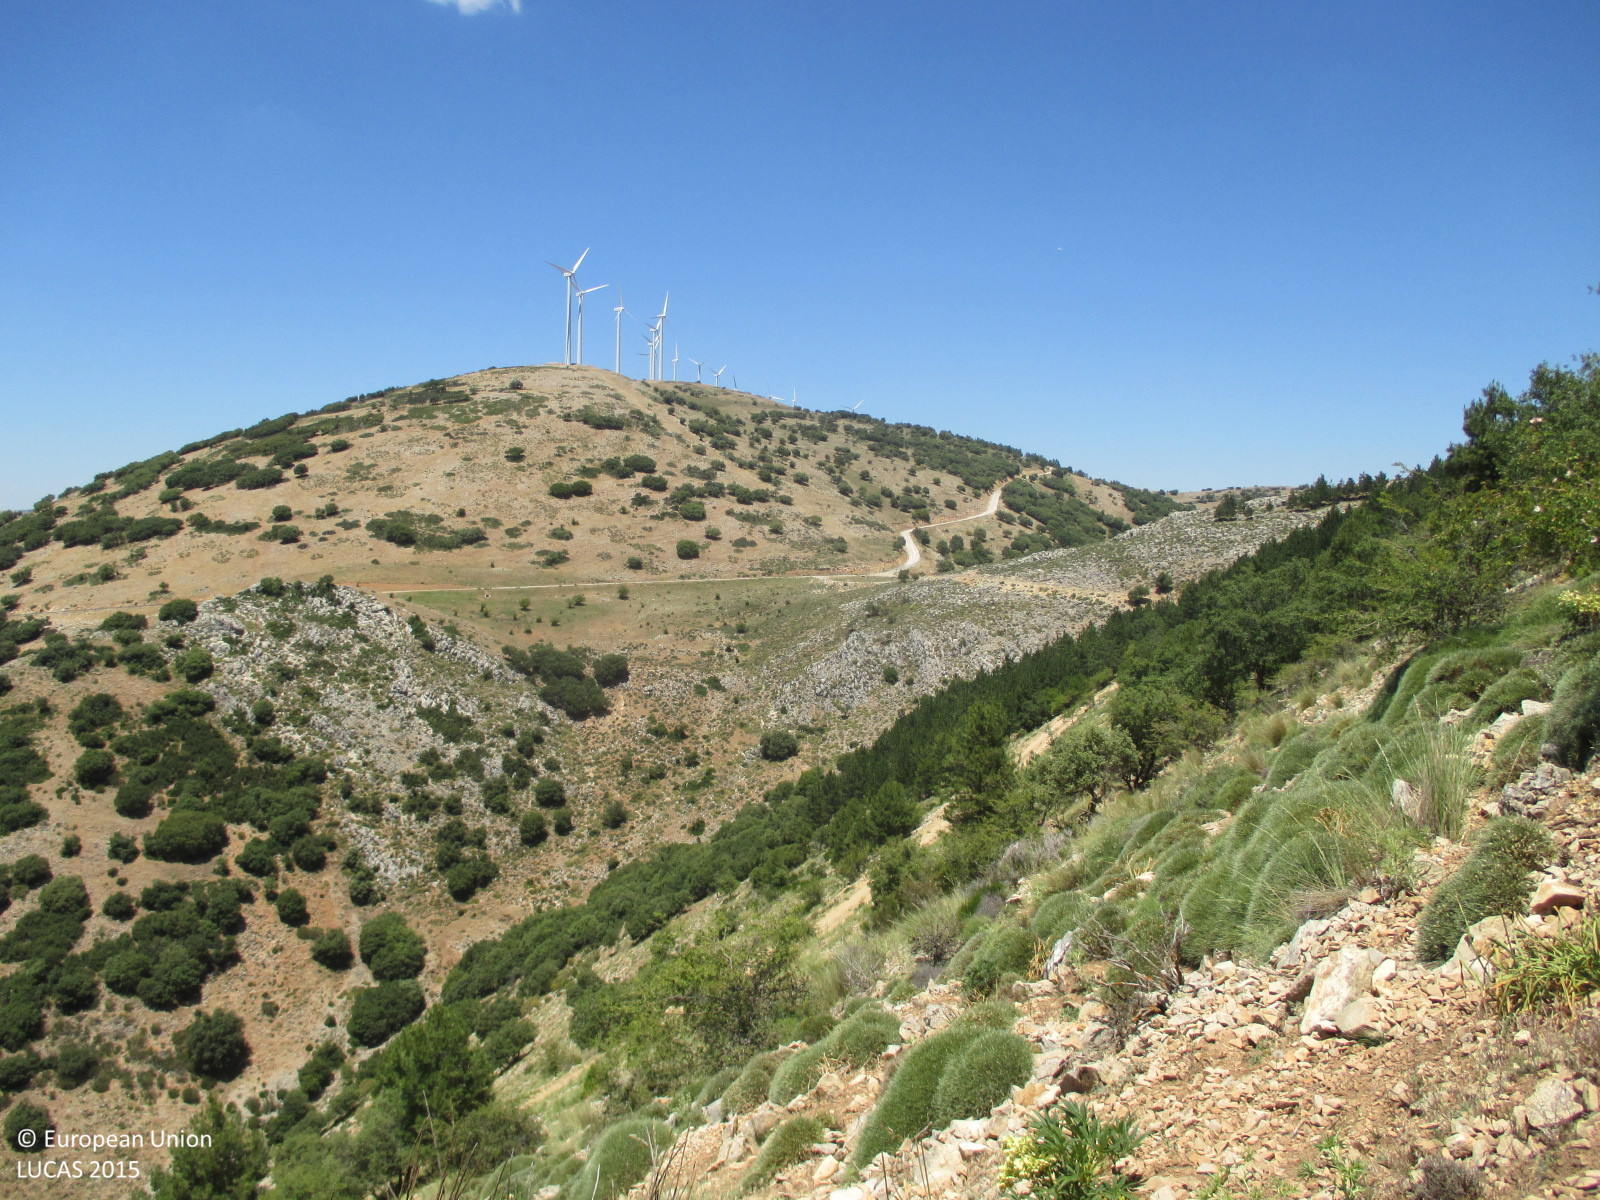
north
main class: Woodland
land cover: Pine dominated coniferous woodland
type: coniferous forest of the mediterranean region
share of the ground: 25 - 50 %
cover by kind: coniferous forest trees 30 %, herbaceous plants 30 %, shrubs 20 %, consolidated bare surface 10 %, unconsolidated bare surface 10 %
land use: Forestry
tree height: > 5 m
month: June
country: ES
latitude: 37.5160
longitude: -3.7425
